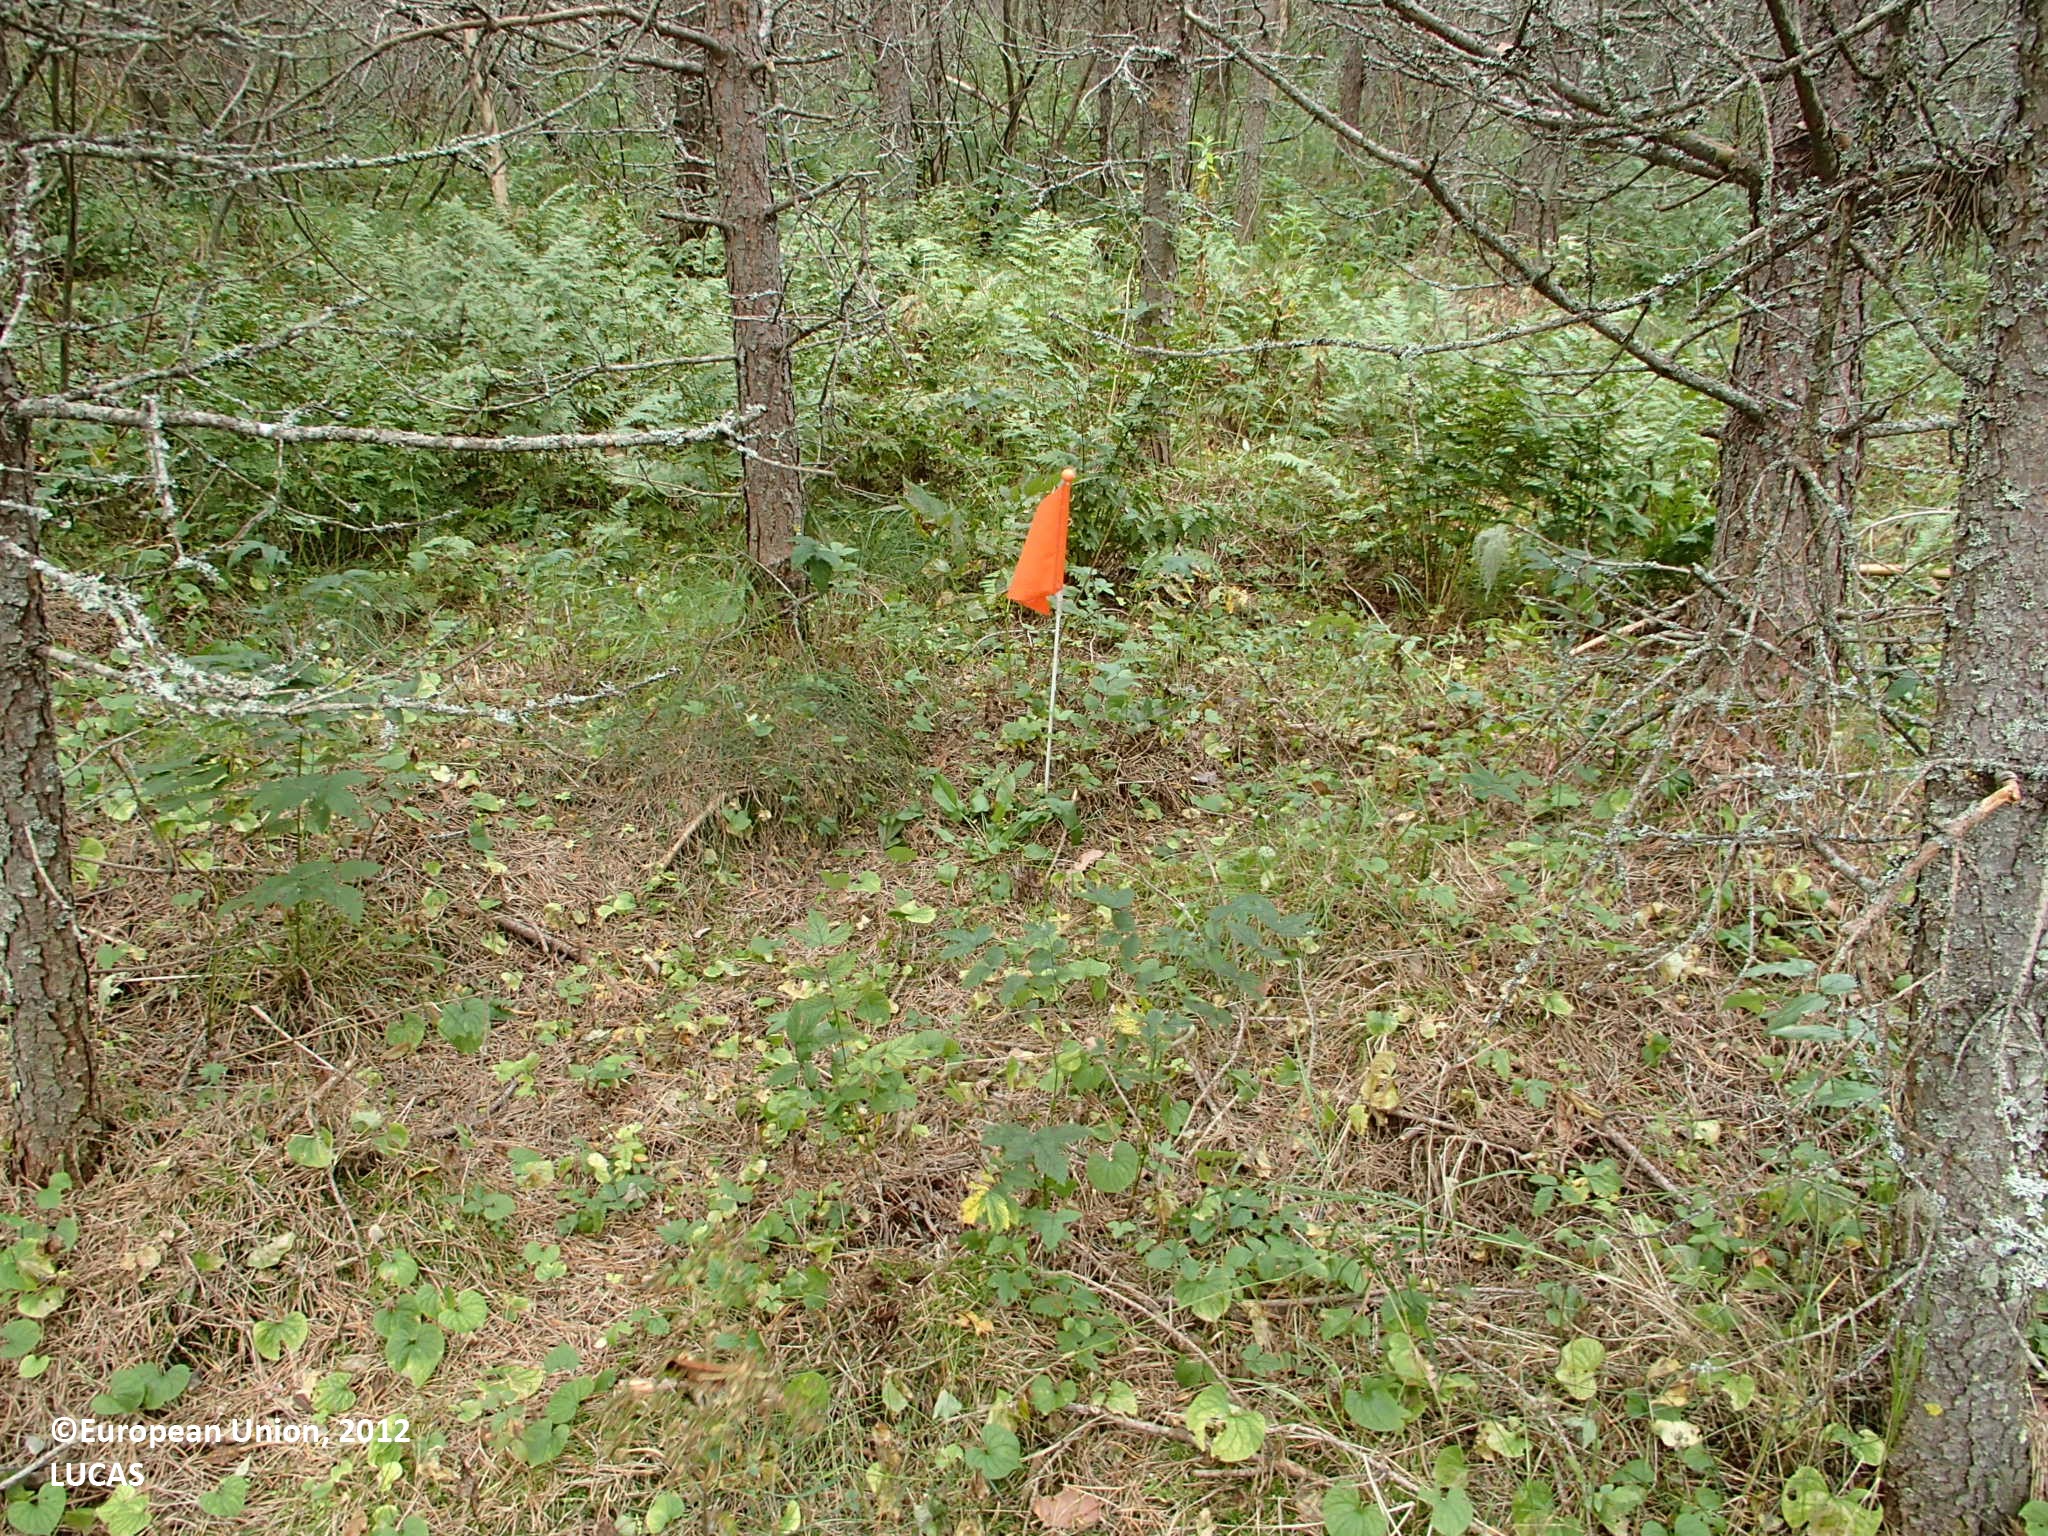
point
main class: Woodland
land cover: Pine dominated coniferous woodland
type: boreal forest
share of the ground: > 75 %
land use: Forestry
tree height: > 5 m
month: September
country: FI
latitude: 63.7433
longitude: 26.0155
